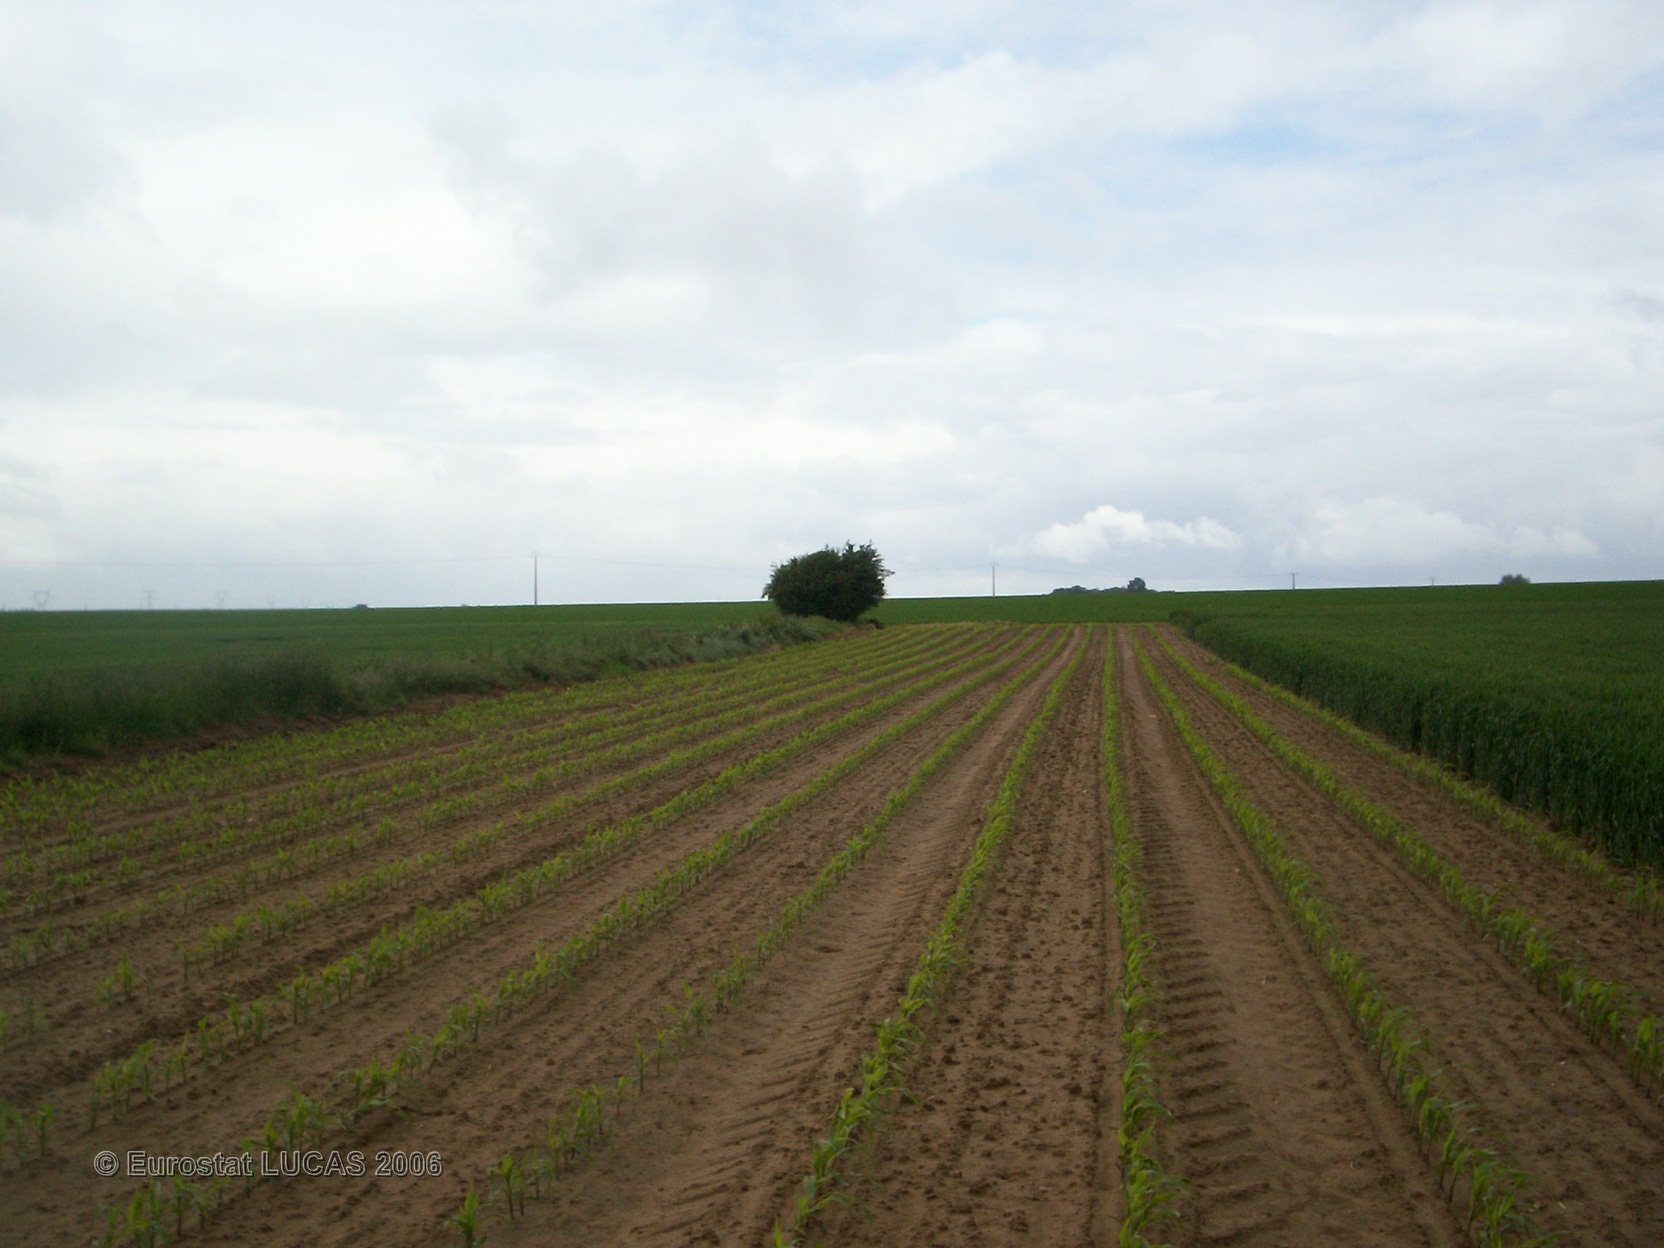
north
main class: Cropland
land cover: Maize
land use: Agriculture (excluding fallow land and kitchen gardens)
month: May
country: FR
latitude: 49.2491
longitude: 2.7498
